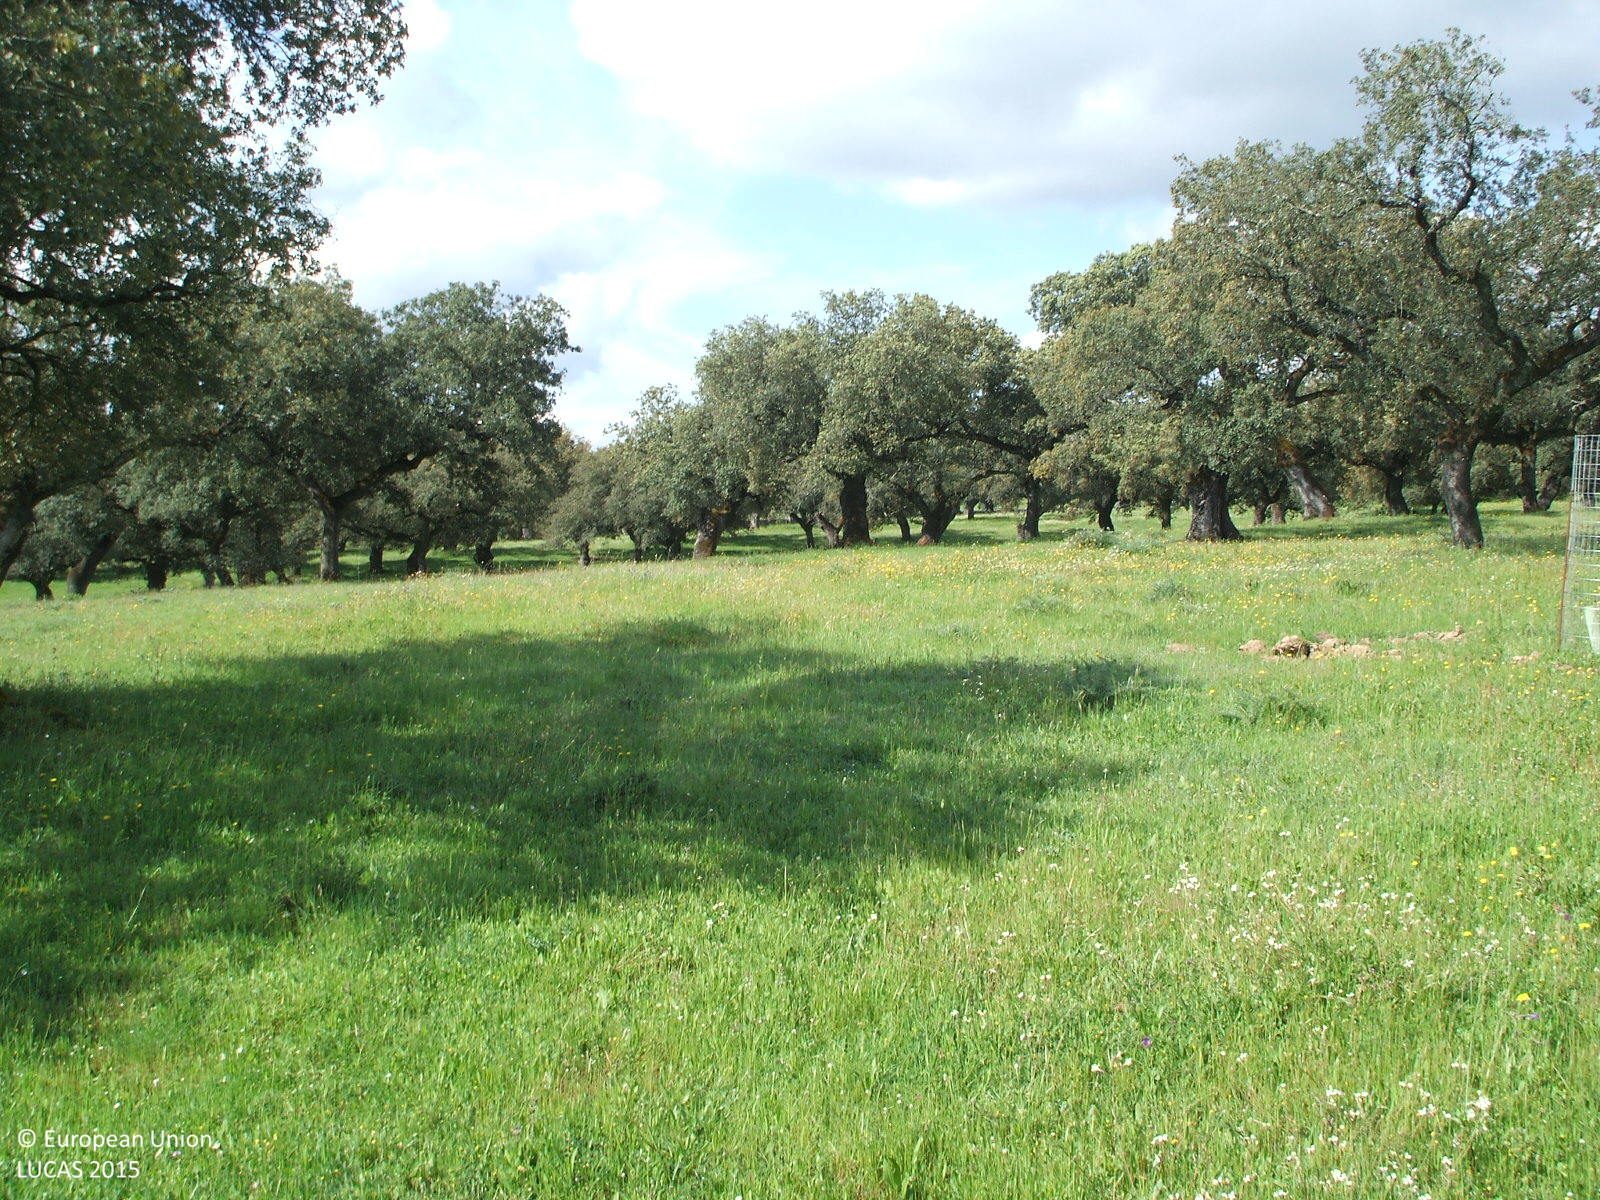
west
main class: Woodland
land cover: Broadleaved woodland
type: broadleaved evergreen forest
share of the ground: 25 - 50 %
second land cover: Grassland without tree/shrub cover
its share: > 75 %
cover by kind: herbaceous plants 75 %, broadleaved forest trees 25 %
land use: Forestry
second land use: Agriculture (excluding fallow land and kitchen gardens)
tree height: > 5 m
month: April
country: ES
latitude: 37.9967
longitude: -6.2669
